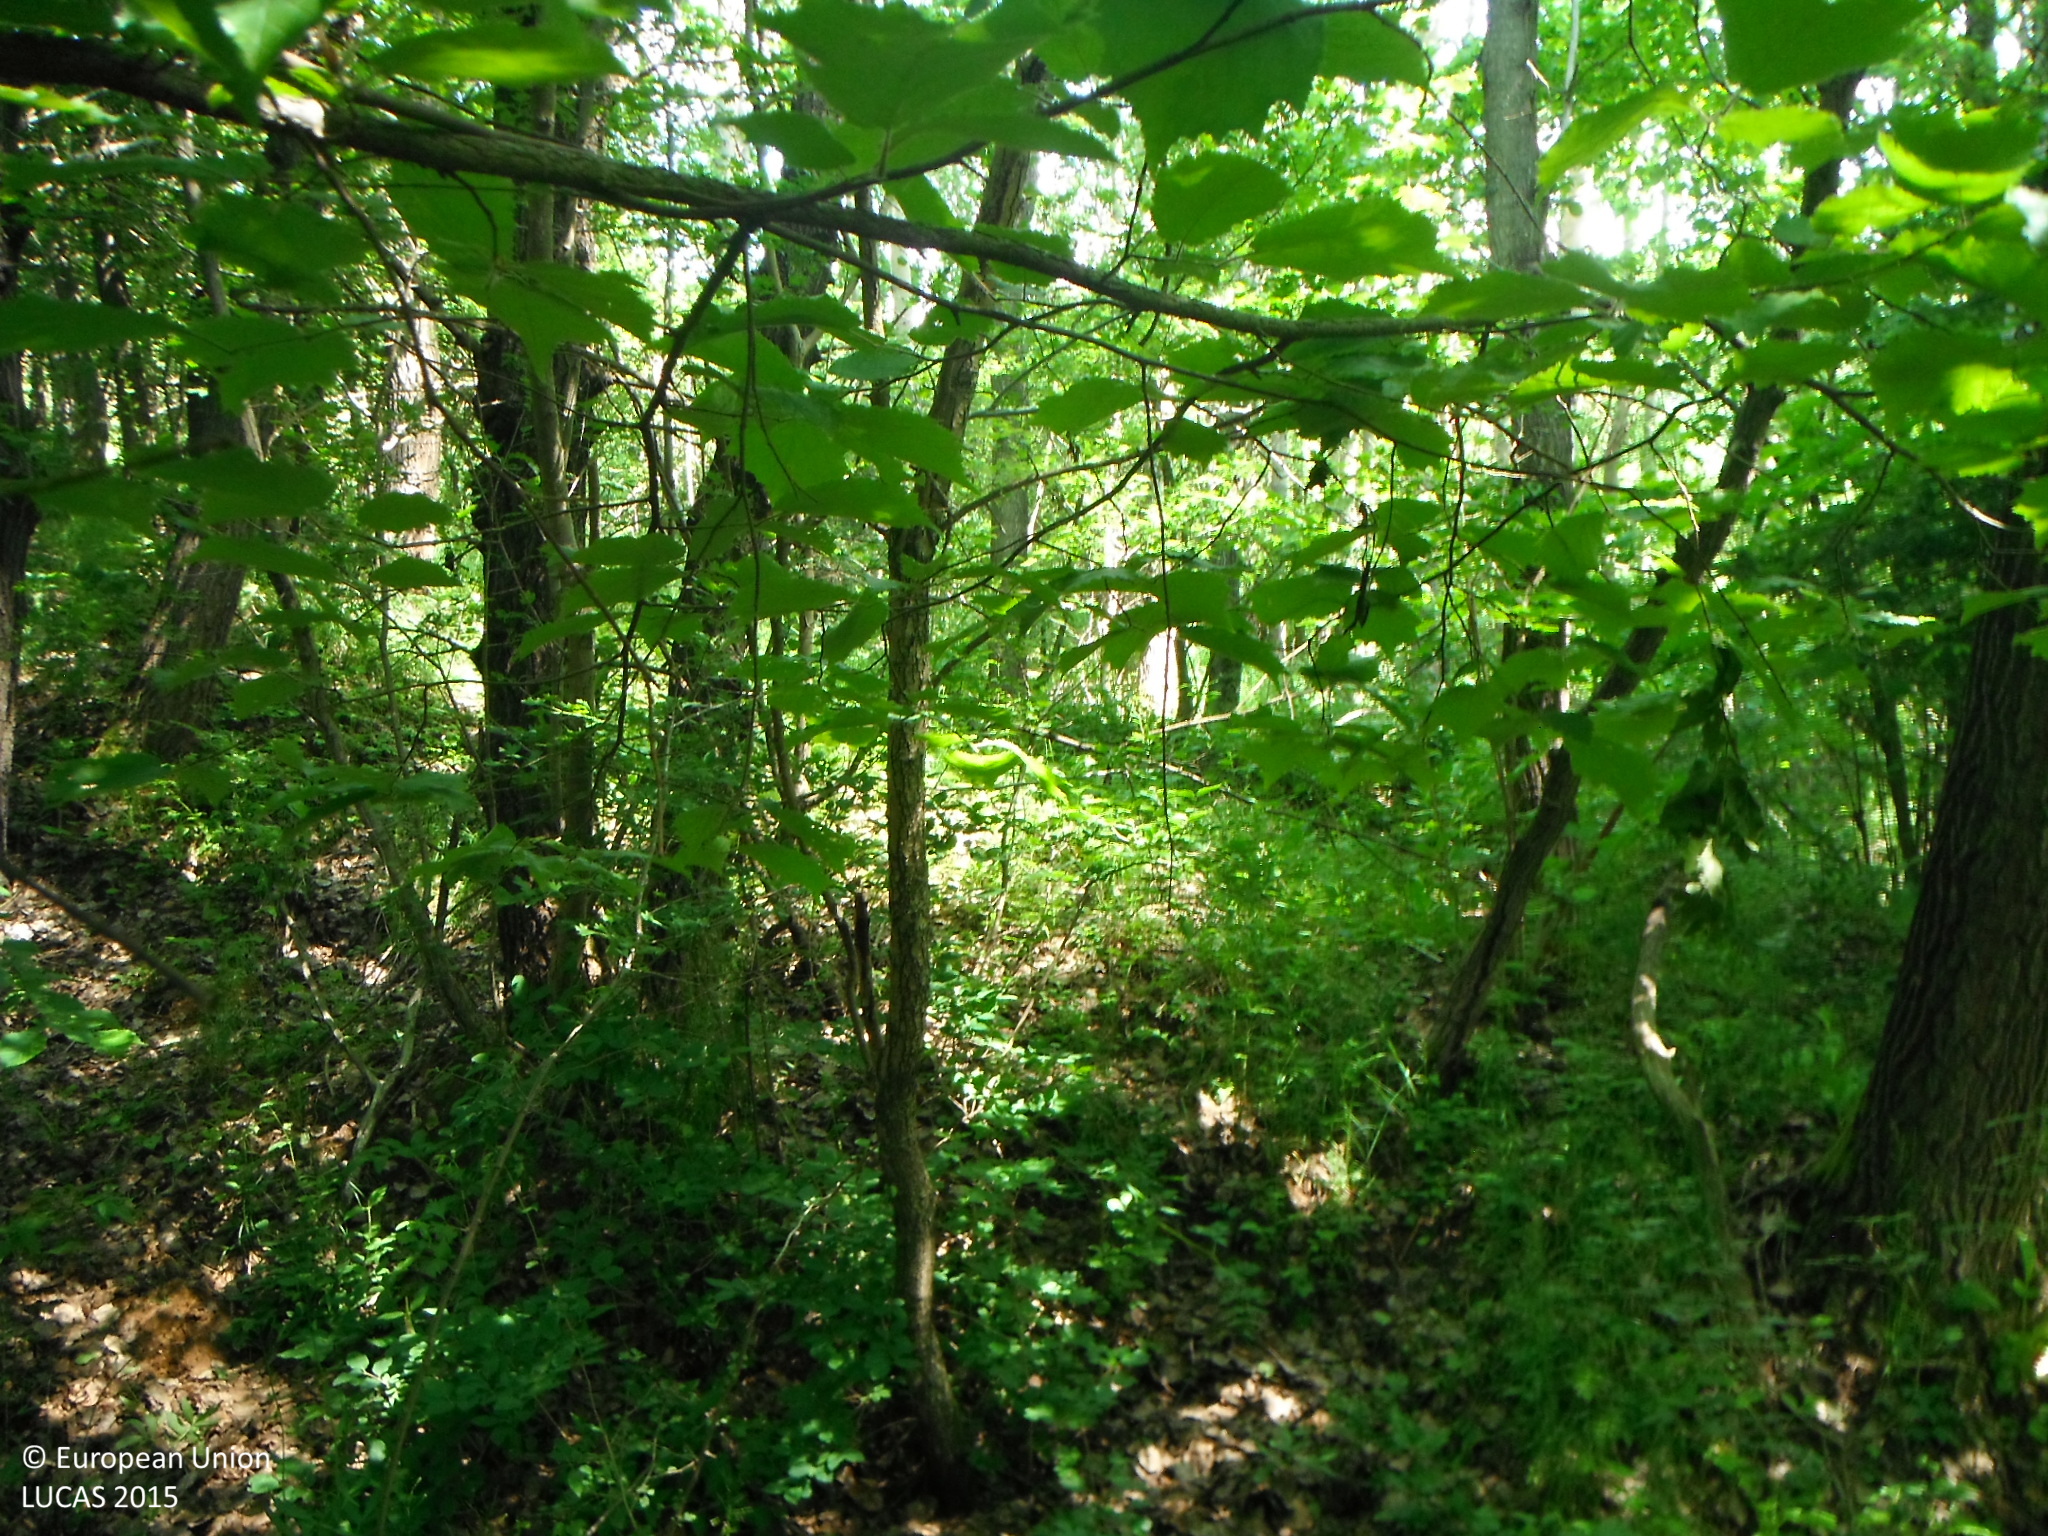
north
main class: Woodland
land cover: Broadleaved woodland
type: mesophytic deciduous forest
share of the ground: > 75 %
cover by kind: broadleaved forest trees 95 %, shrubs 5 %
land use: Semi-natural and natural areas not in use
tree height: > 5 m
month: June
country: SK
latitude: 48.8159
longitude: 19.6278
